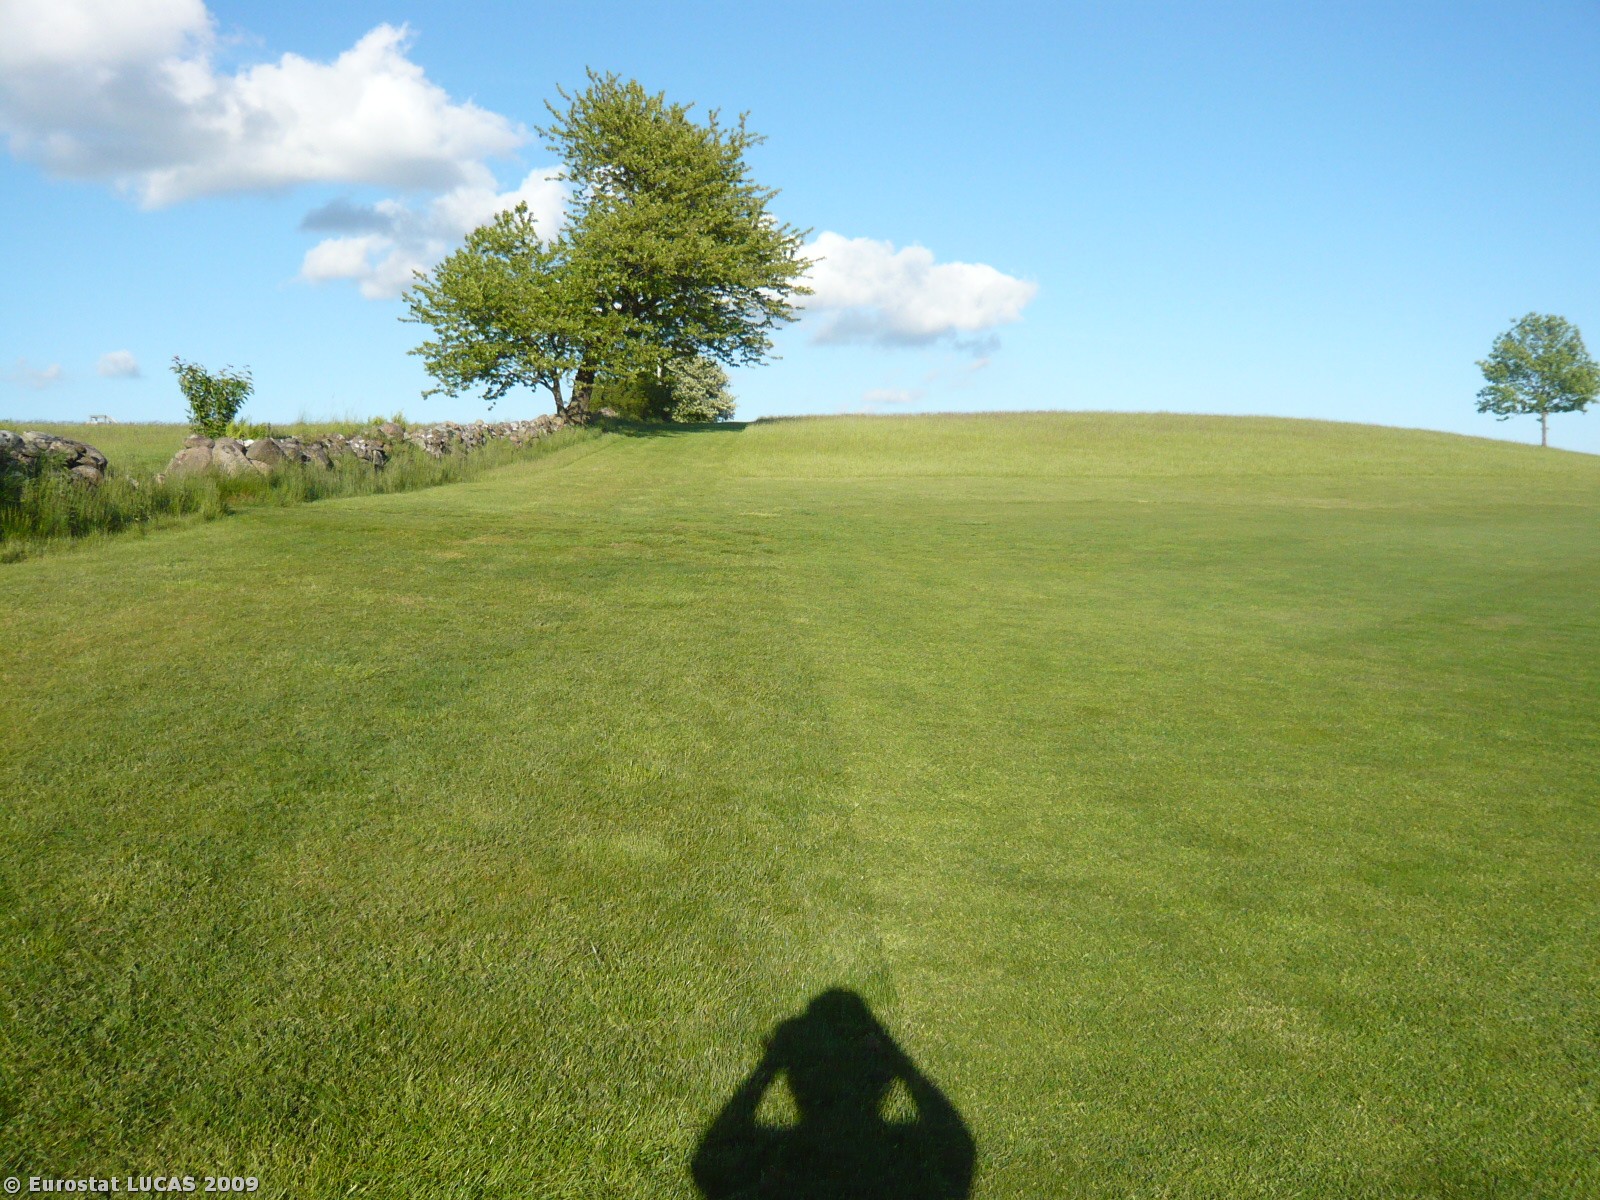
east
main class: Grassland
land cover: Grassland without tree/shrub cover
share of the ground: > 75 %
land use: Sport
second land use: Amenities, museums, leisure
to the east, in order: Grassland without tree/shrub cover; Dry stone walls; Grassland without tree/shrub cover; Dry stone walls; Electric lines; Nurseries
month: May
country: DK
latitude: 55.3872
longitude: 11.5615
